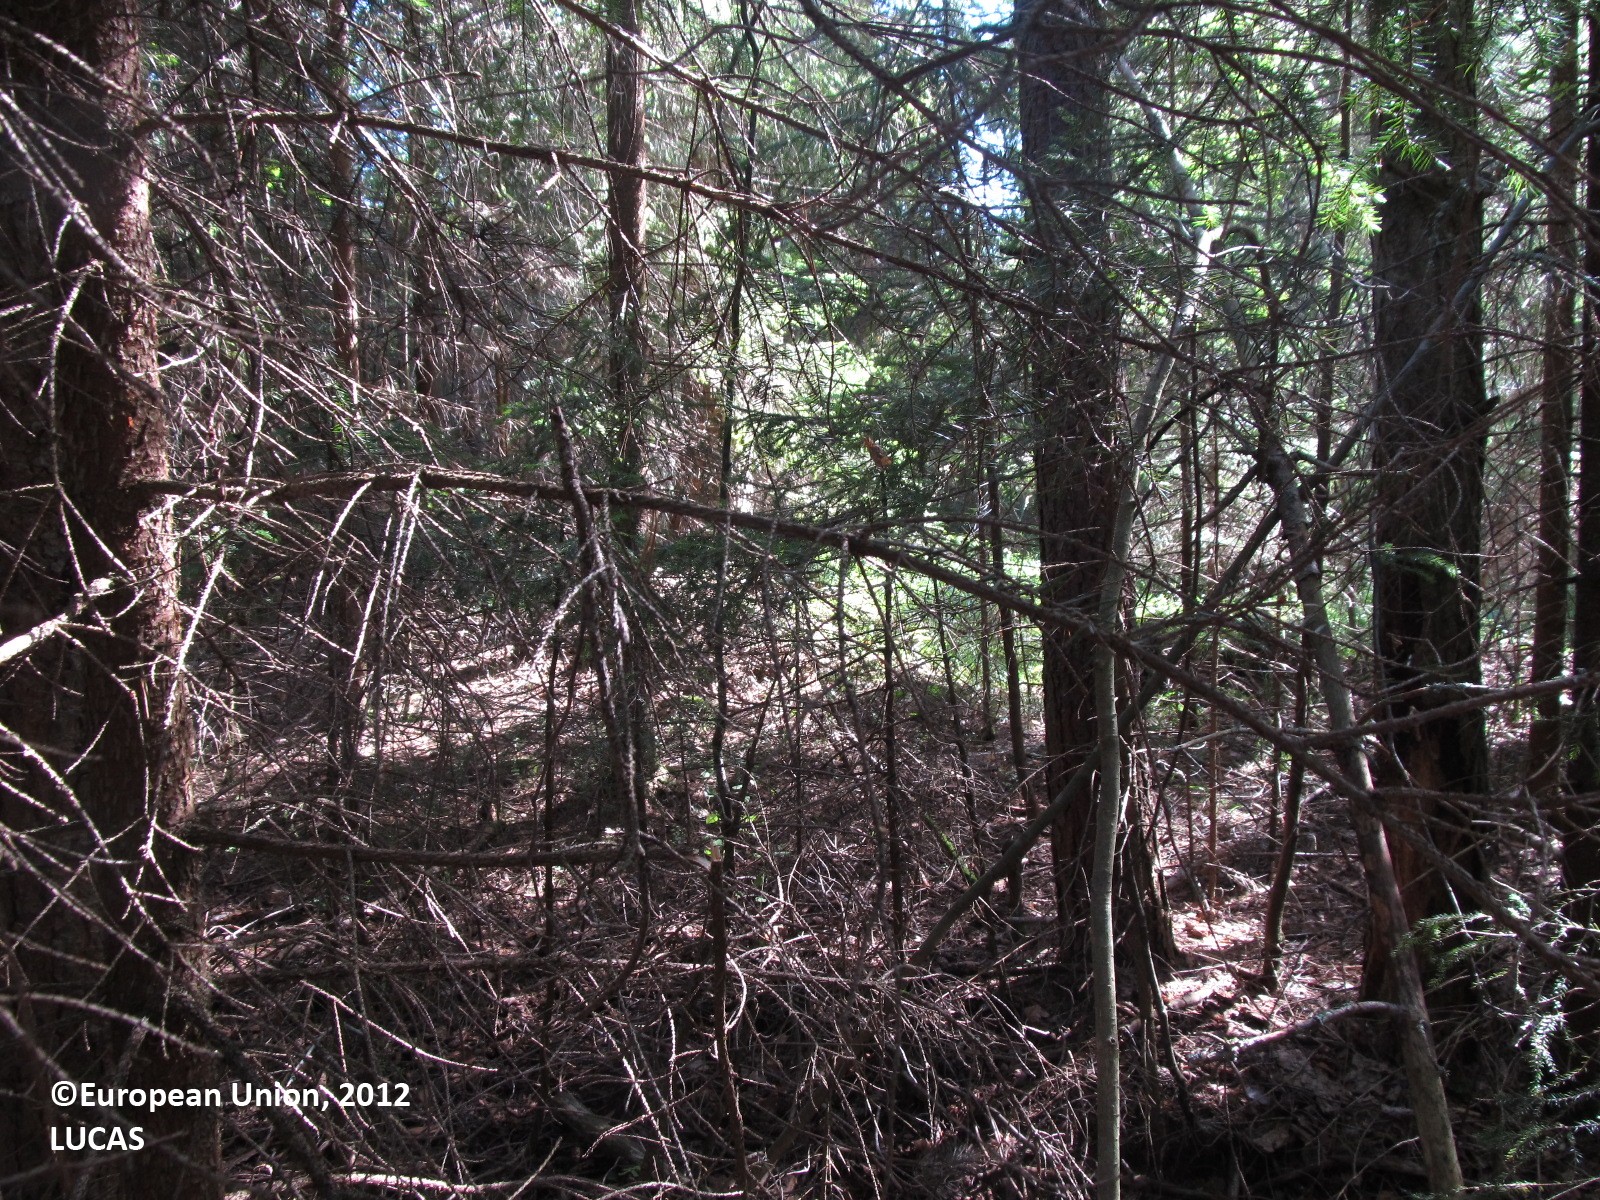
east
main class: Woodland
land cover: Spruce dominated coniferous woodland
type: boreal forest
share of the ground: 25 - 50 %
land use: Forestry
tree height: > 5 m
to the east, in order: Spruce dominated coniferous woodland; Spruce dominated mixed woodland; Broadleaved woodland; Grass margins; Paved roads, cycling and walking lanes; Grass margins
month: August
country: FI
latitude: 62.3274
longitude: 27.7210
